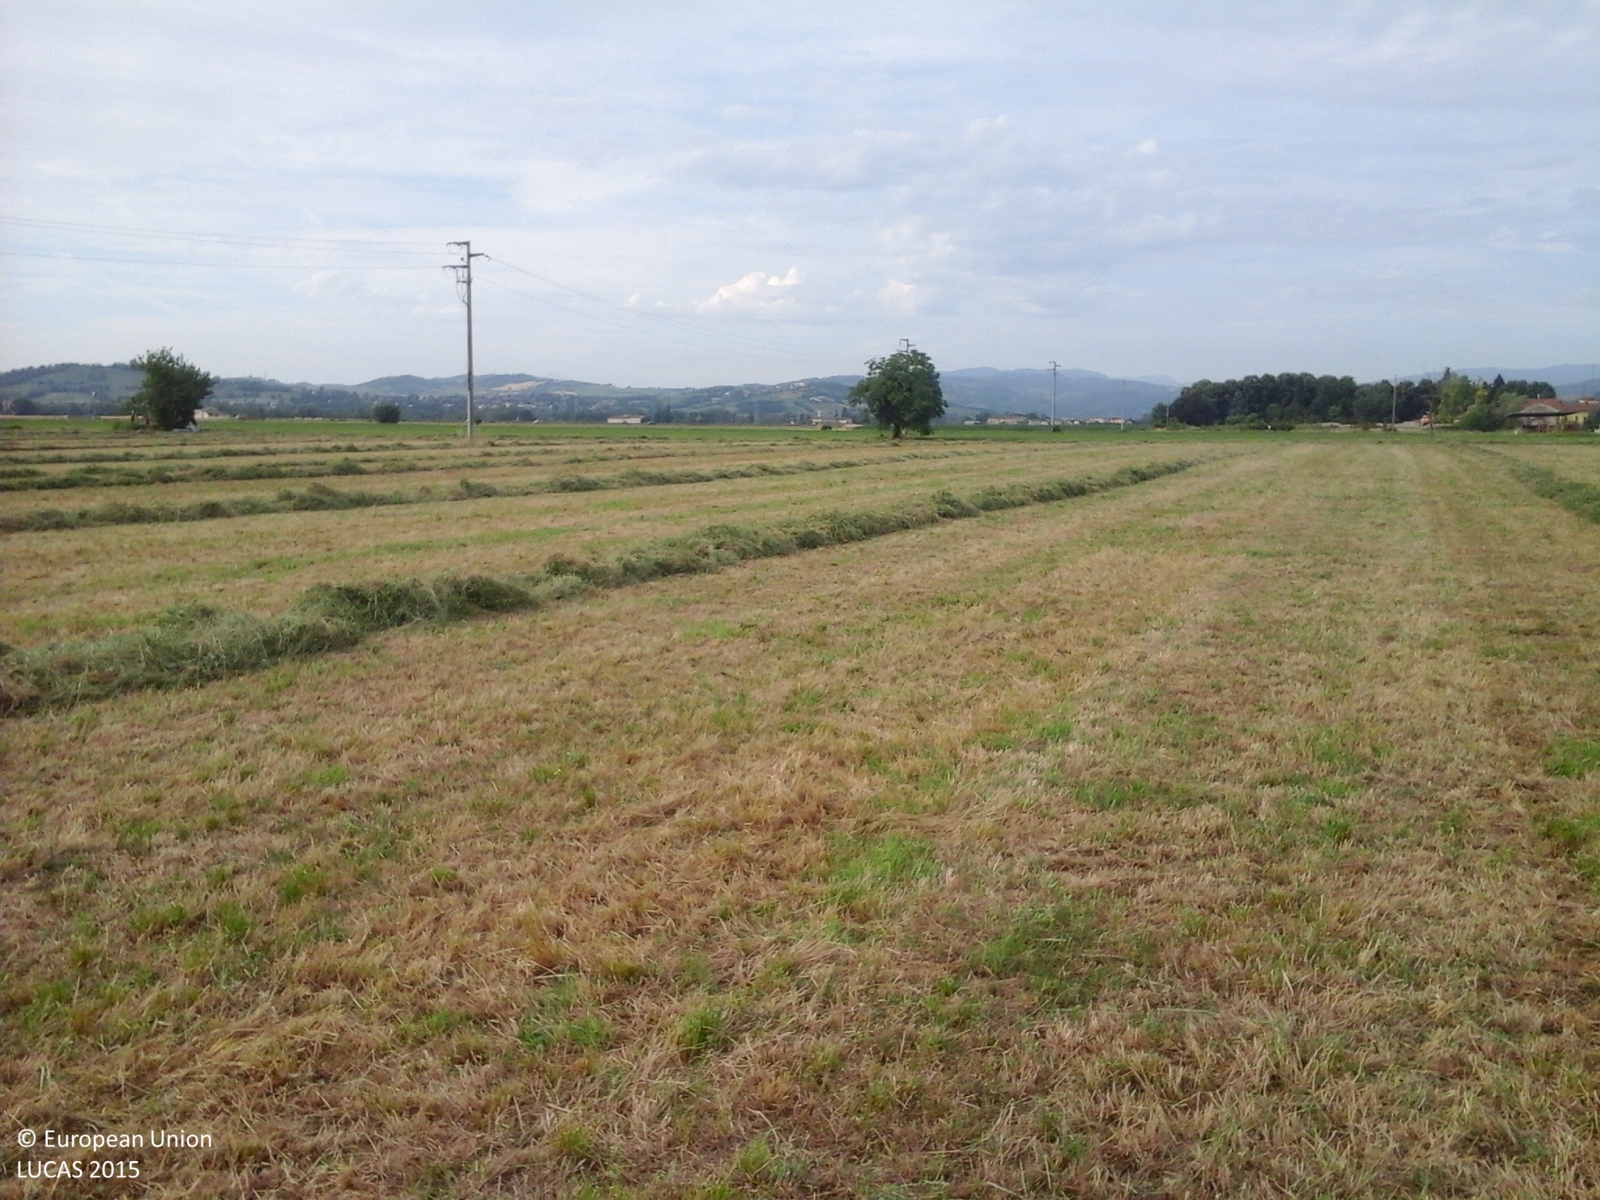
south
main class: Cropland
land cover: Lucerne
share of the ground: > 75 %
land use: Agriculture (excluding fallow land and kitchen gardens)
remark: Clear cut
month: June
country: IT
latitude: 44.6748
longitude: 10.2895
